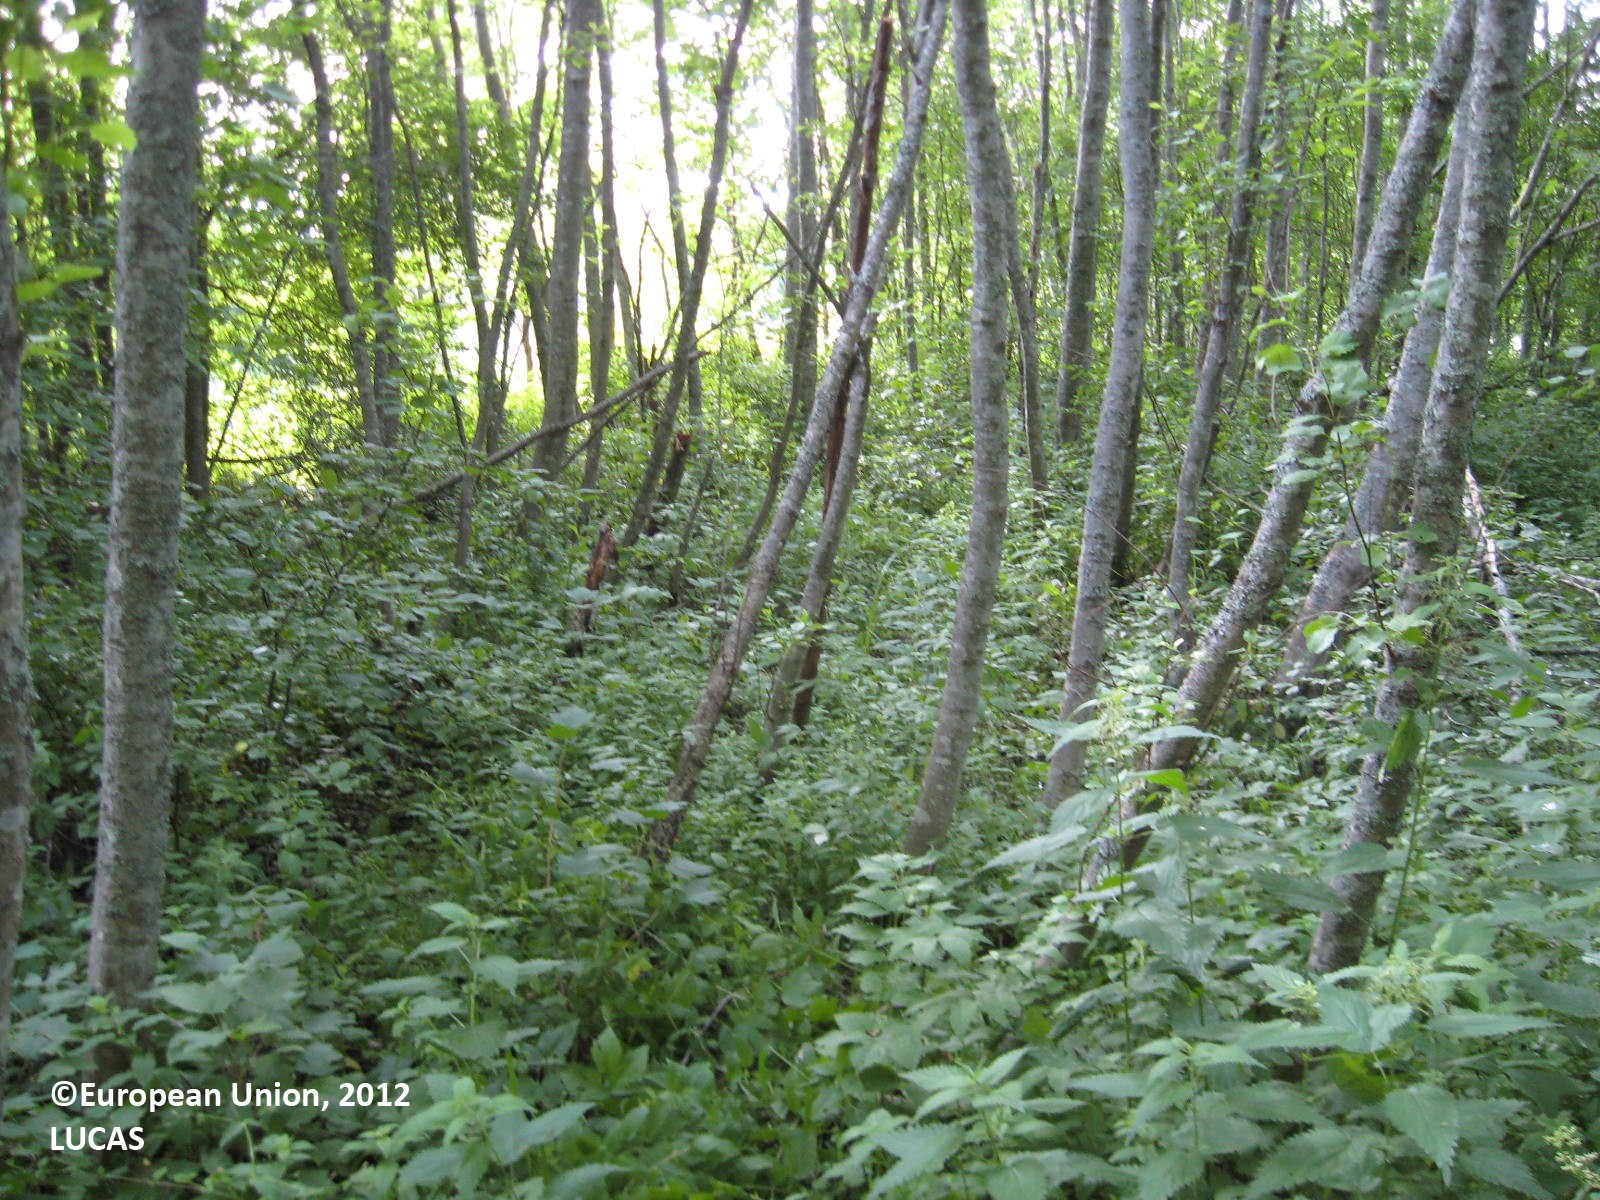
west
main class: Woodland
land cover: Broadleaved woodland
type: boreal forest
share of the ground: > 75 %
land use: Semi-natural and natural areas not in use
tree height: > 5 m
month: July
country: FI
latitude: 62.2347
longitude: 21.6109
